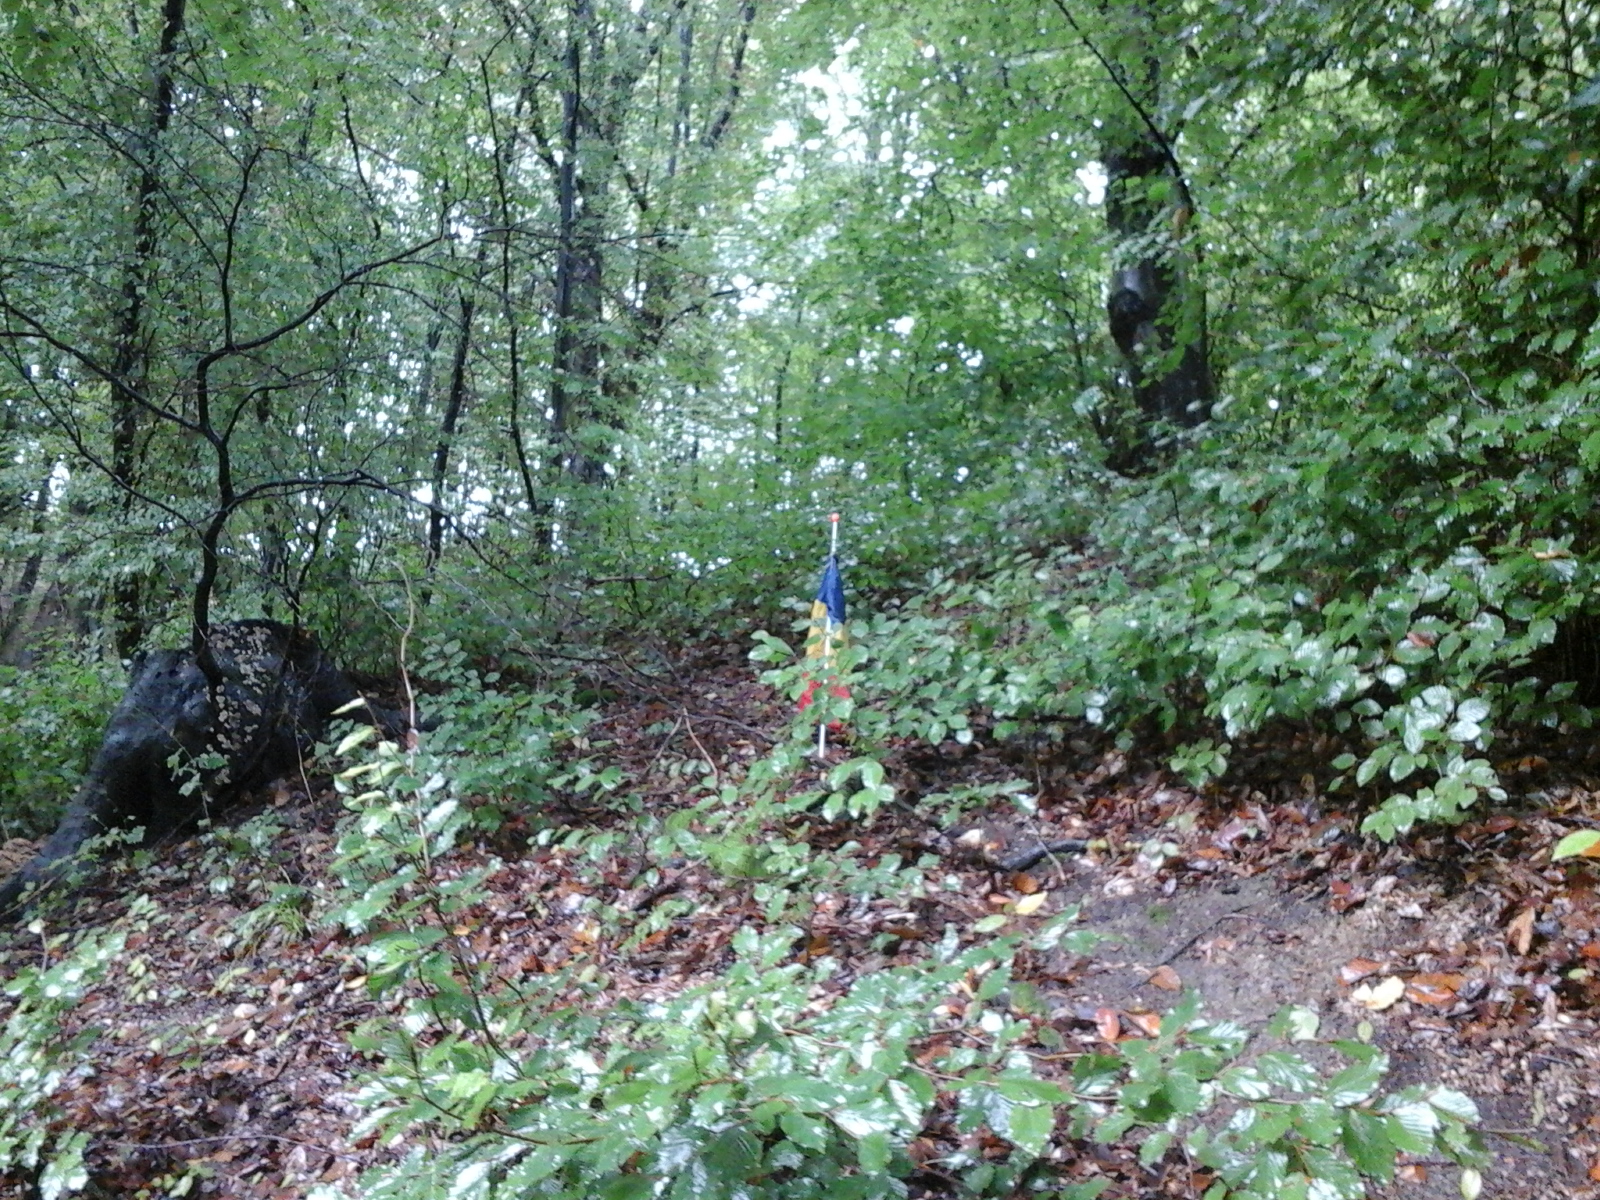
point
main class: Woodland
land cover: Broadleaved woodland
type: acidophilous oak and oak-birch forest
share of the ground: > 75 %
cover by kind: broadleaved forest trees 100 %
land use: Forestry
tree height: > 5 m
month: September
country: RO
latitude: 45.0645
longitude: 23.6882
